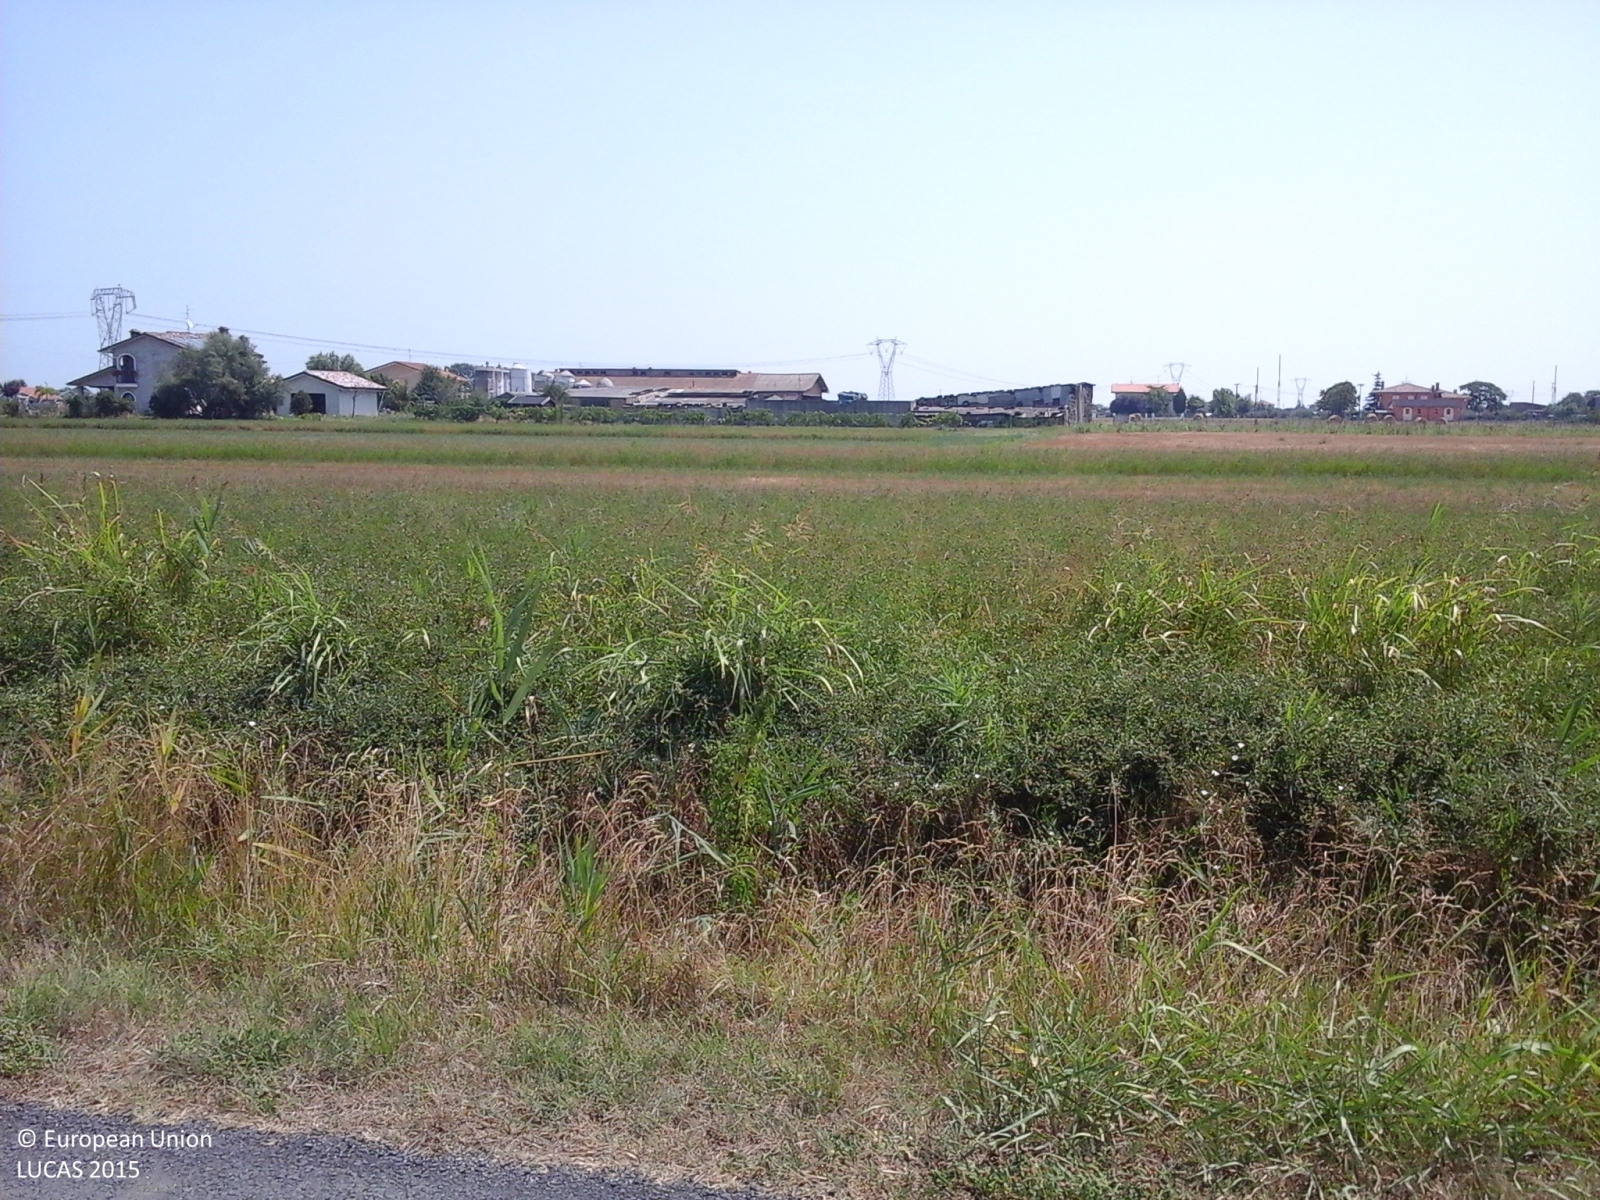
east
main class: Cropland
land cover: Other cereals
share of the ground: > 75 %
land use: Agriculture (excluding fallow land and kitchen gardens)
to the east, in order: Other cereals; Ditches and canals; Other cereals; Ditches and canals; Other cereals; Ditches and canals; Grass margins; Paved roads, cycling and walking lanes; Grass margins; Rivers and streams; Grass margins; Lucerne; Ditches and canals; Common wheat; Ditches and canals; Common wheat; Ditches and canals; Common wheat; Ditches and canals; Potatoes; Ditches and canals; Grass margins; Artificial constructions in urban areas
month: July
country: IT
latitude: 44.1242
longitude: 12.4065
